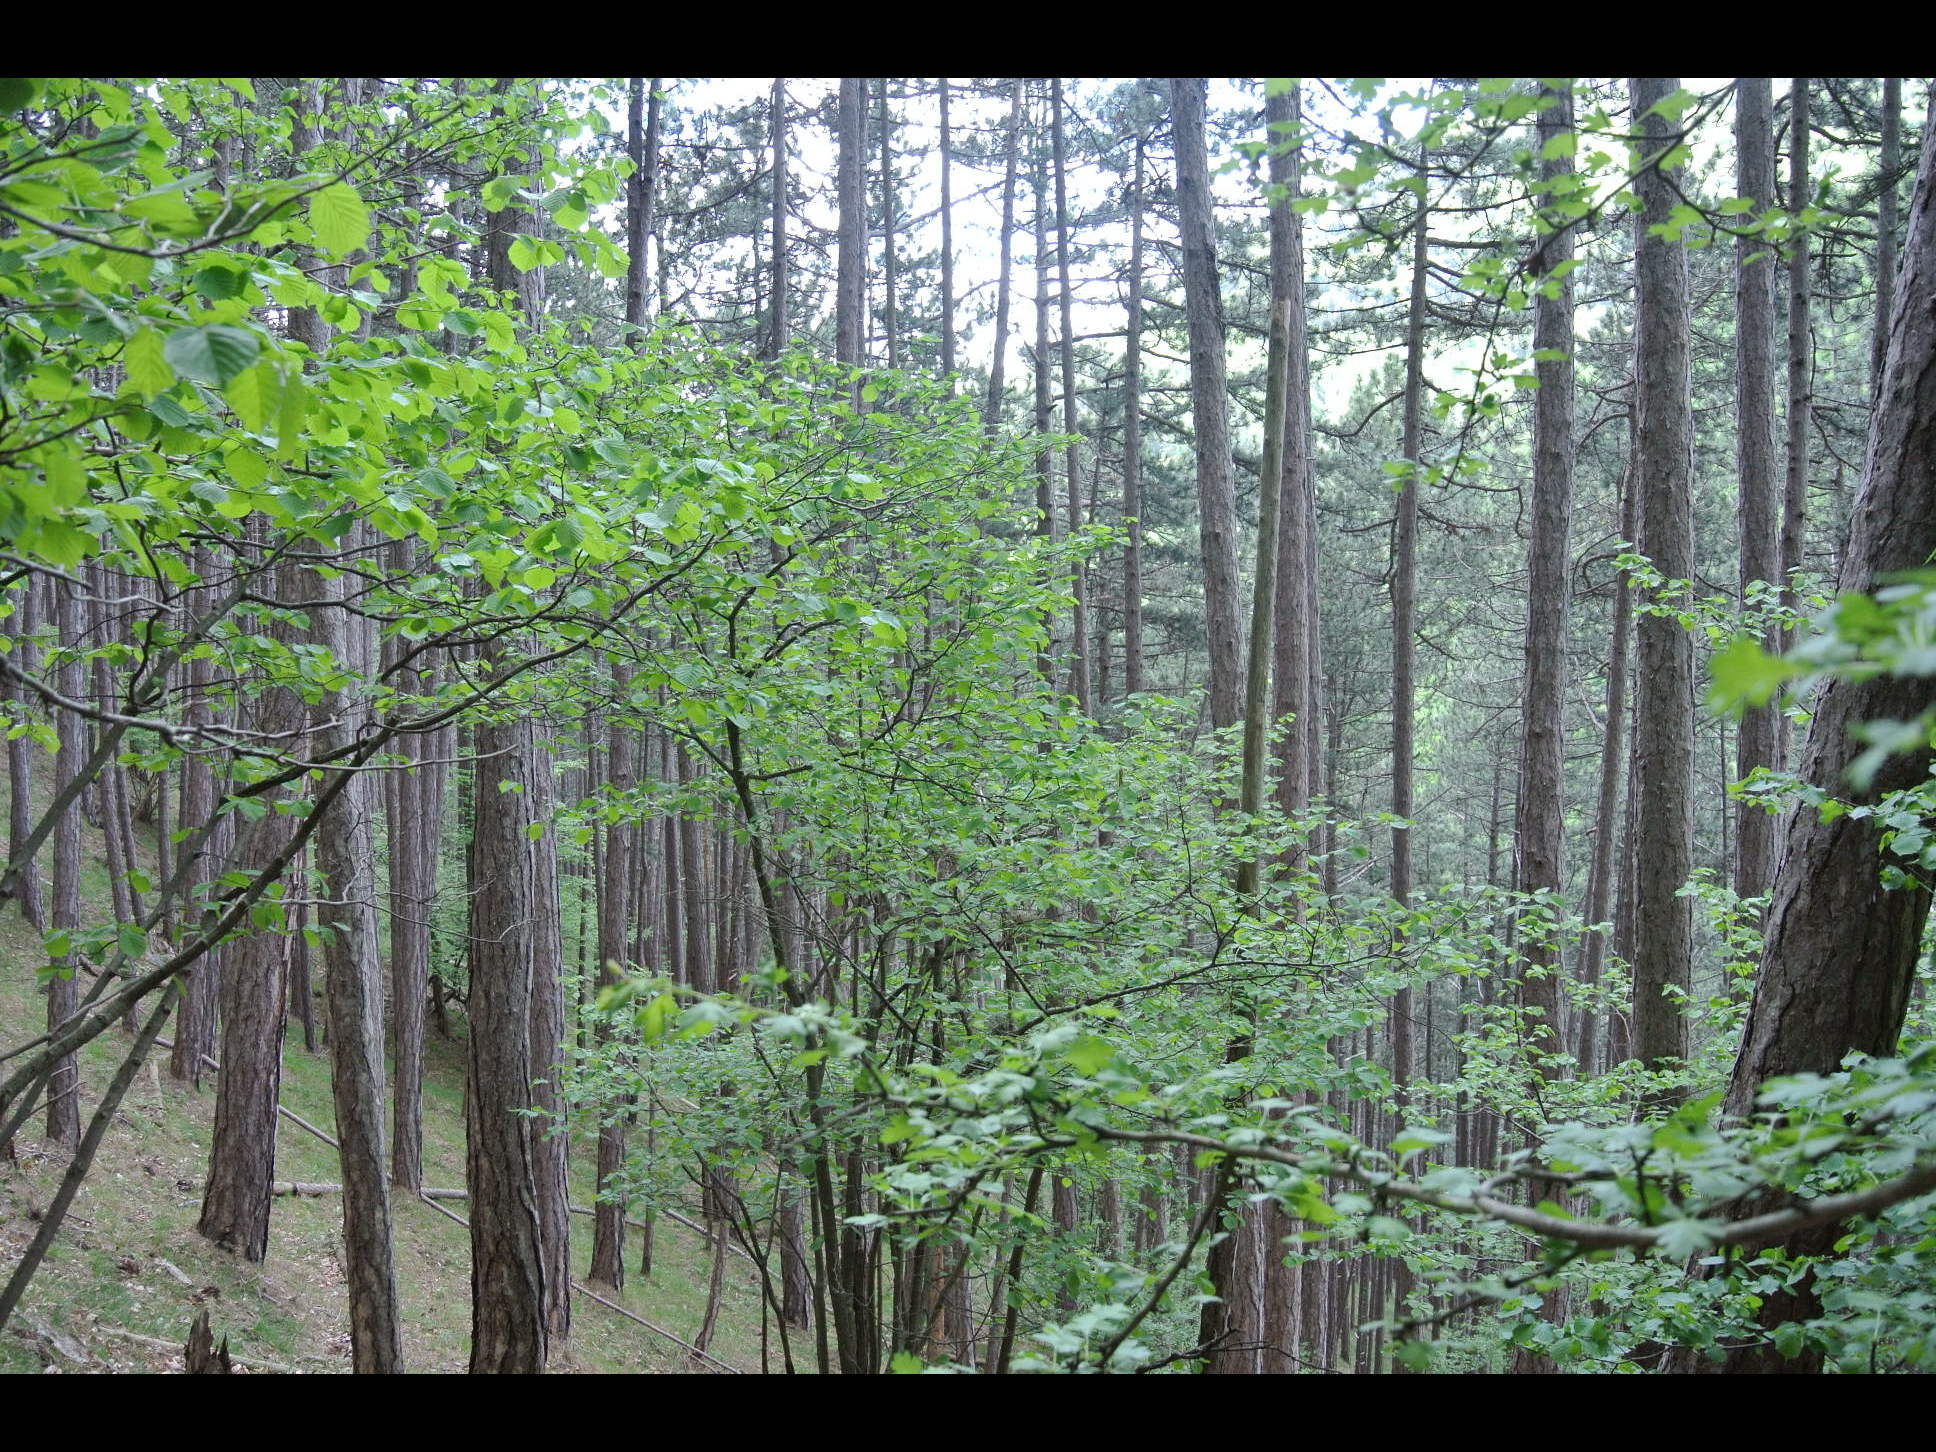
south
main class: Woodland
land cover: Pine dominated coniferous woodland
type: alpine coniferous forest
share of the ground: > 75 %
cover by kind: coniferous forest trees 95 %, broadleaved forest trees 5 %
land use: Forestry
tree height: > 5 m
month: May
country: AT
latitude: 47.8778
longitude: 16.0336
